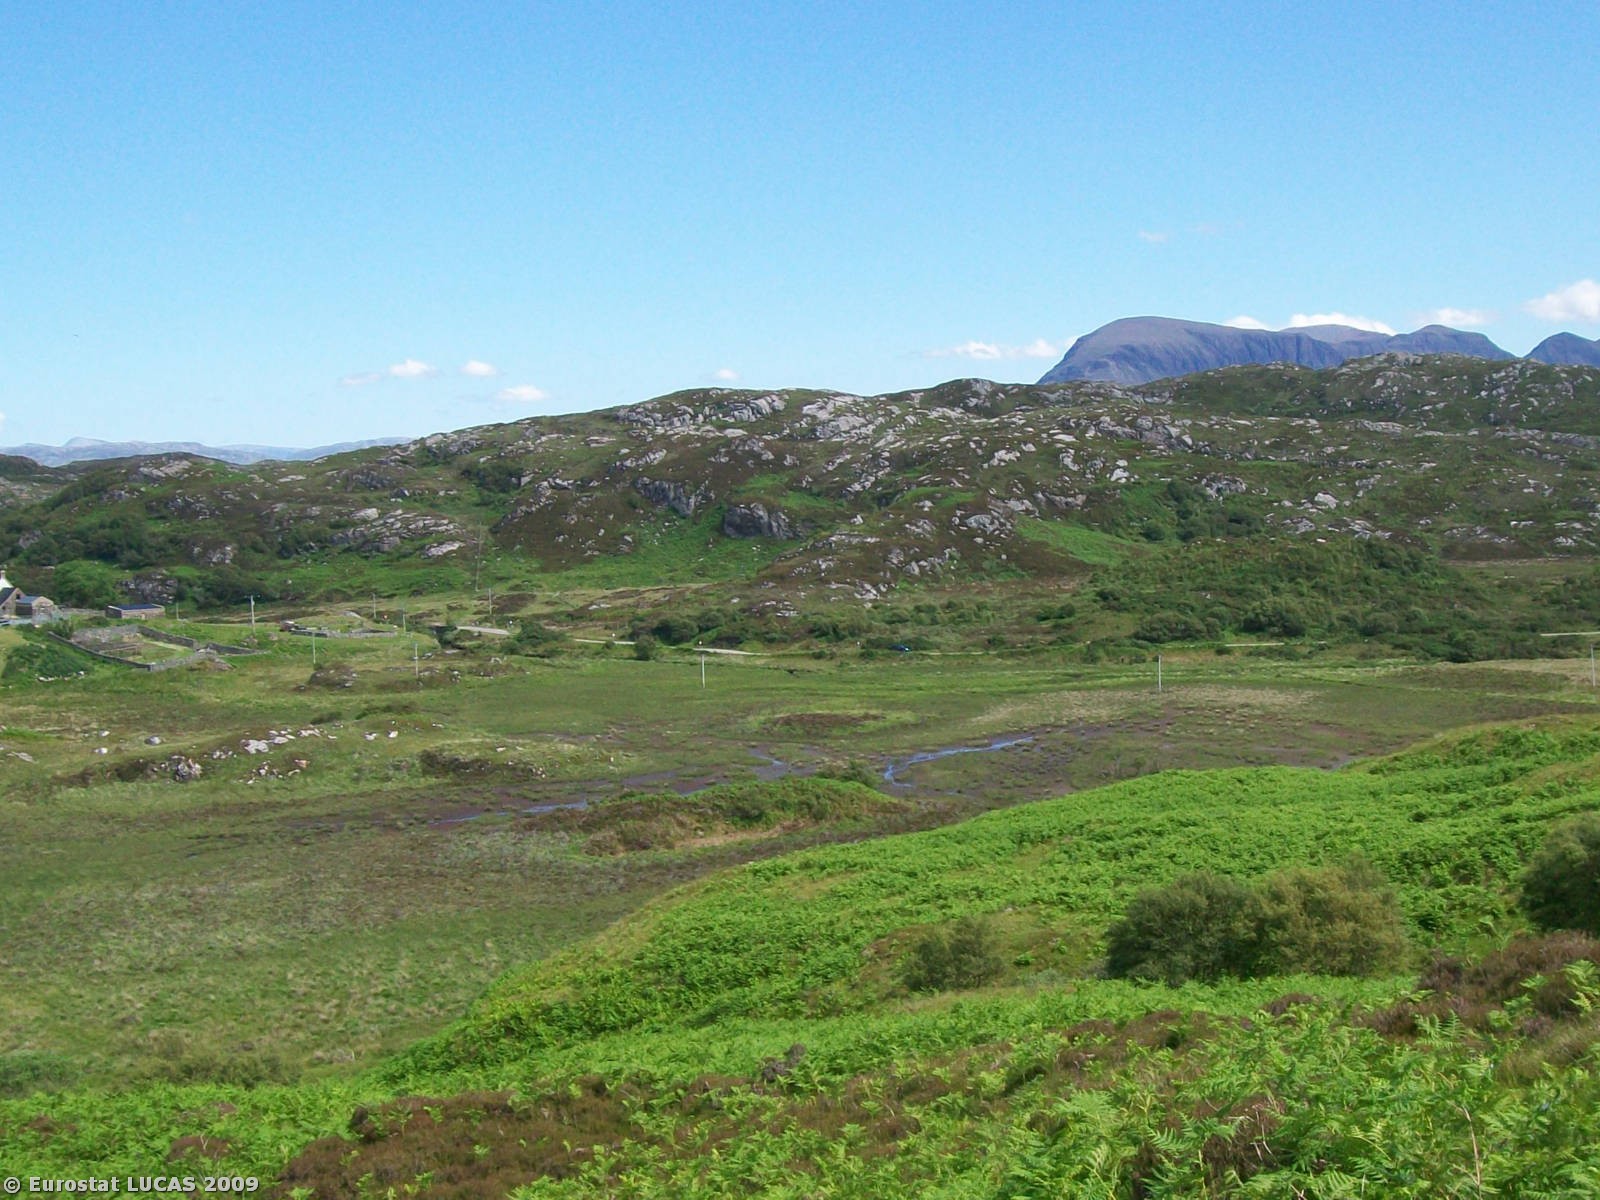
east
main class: Shrubland
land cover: Shrubland without tree cover
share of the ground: > 75 %
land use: Unused
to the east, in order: Shrubland without tree cover; Grassland without tree/shrub cover; Fences; Grassland without tree/shrub cover; Grassland with sparse tree/shrub cover; Rivers and streams; Broadleaved woodland; Grassland without tree/shrub cover; Fences; Grassland without tree/shrub cover; Shrubland without tree cover
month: June
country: GB
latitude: 58.2416
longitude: -5.2476
